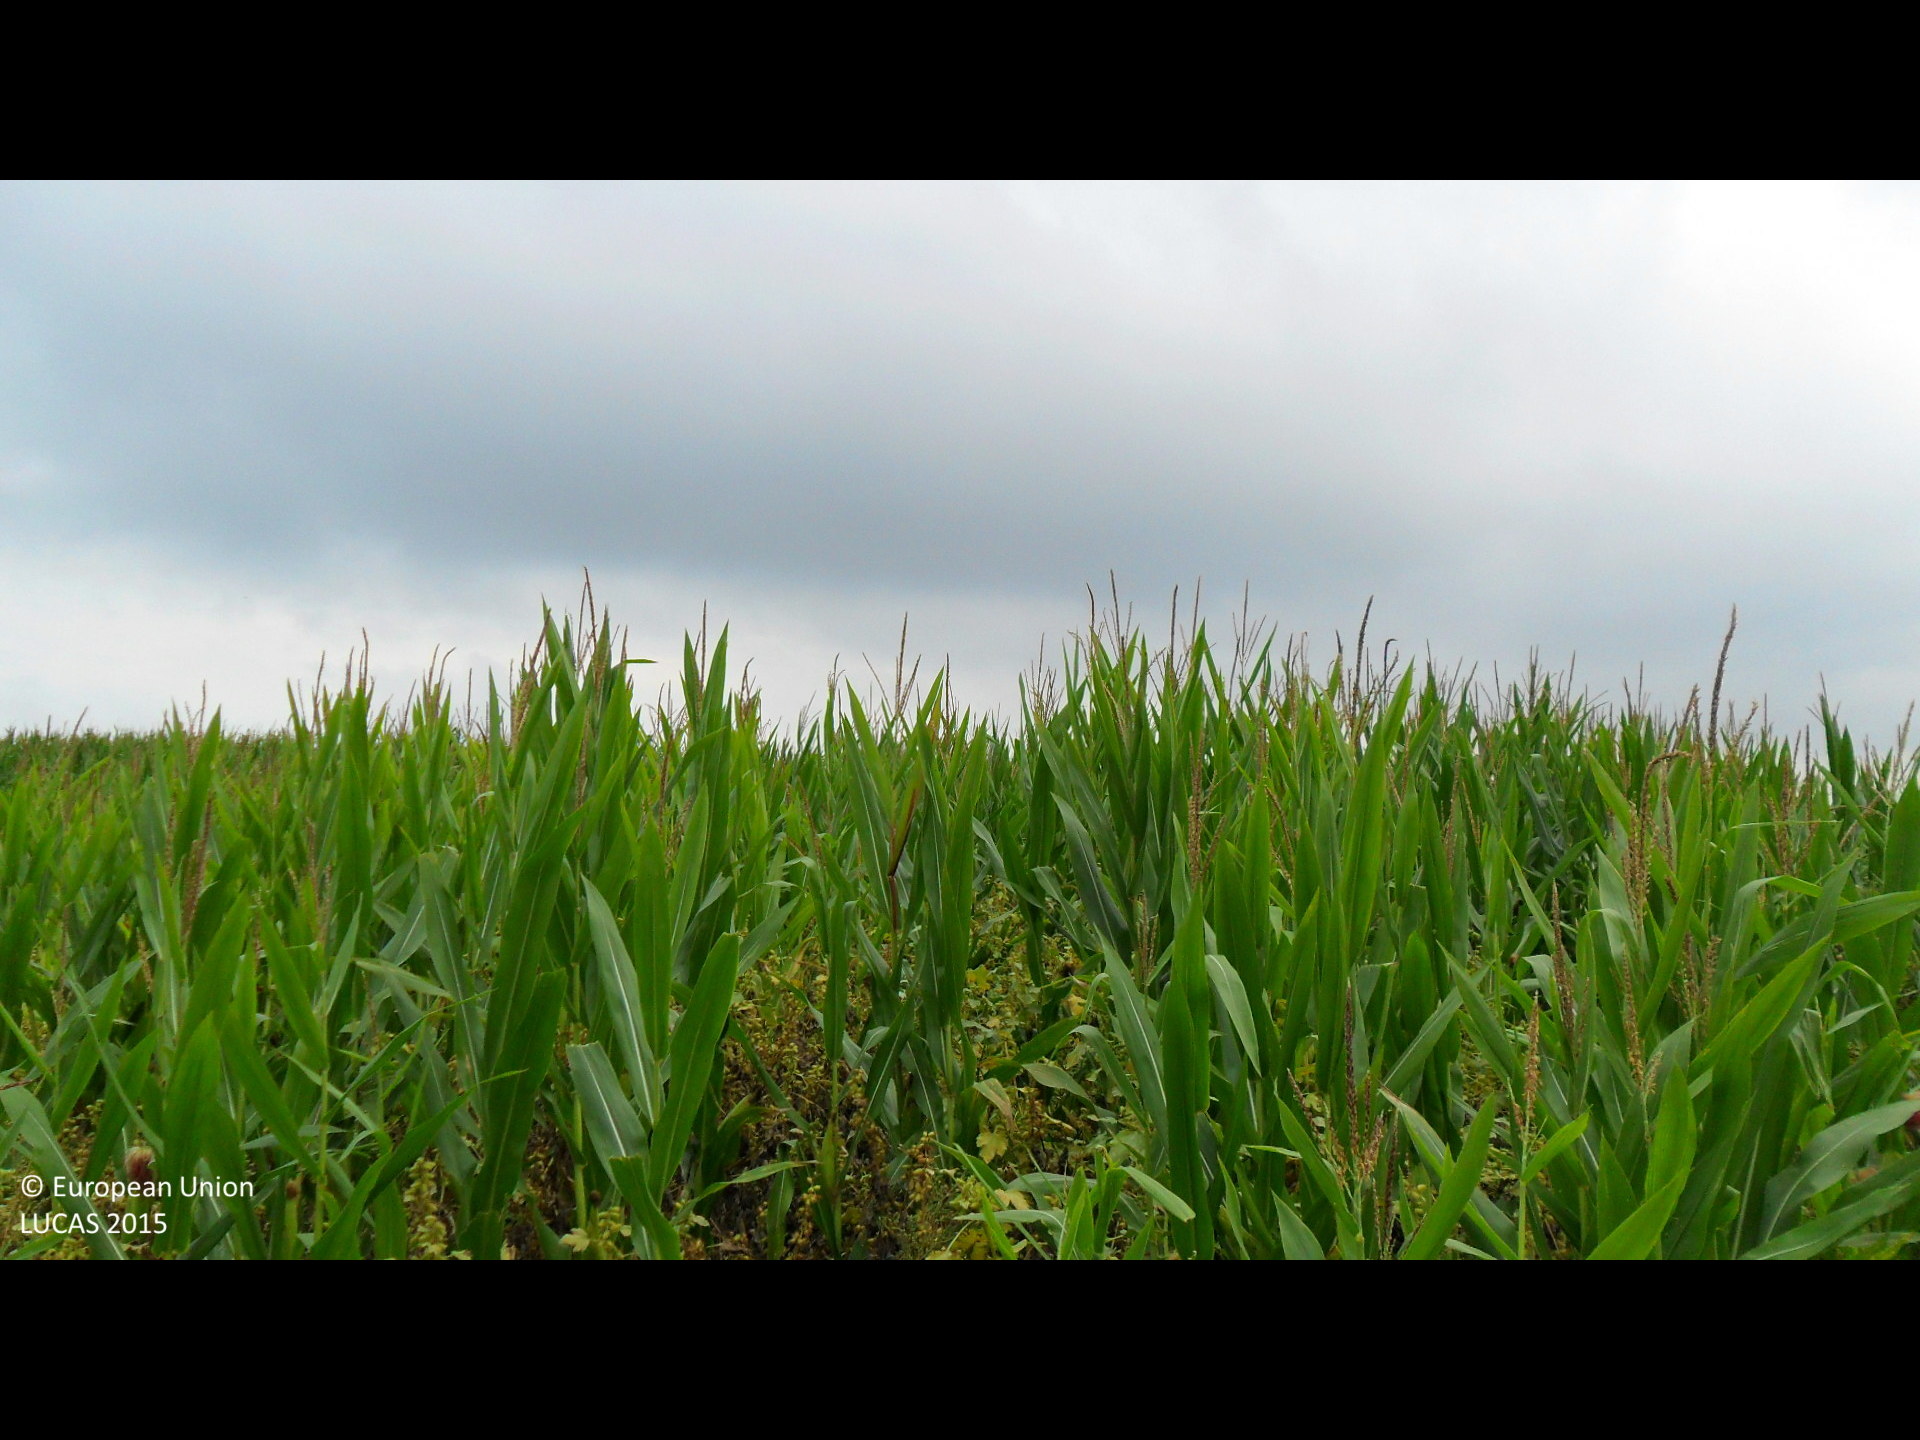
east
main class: Cropland
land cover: Maize
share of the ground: > 75 %
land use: Agriculture (excluding fallow land and kitchen gardens)
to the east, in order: Maize
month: September
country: BG
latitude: 43.0805
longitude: 26.3460
